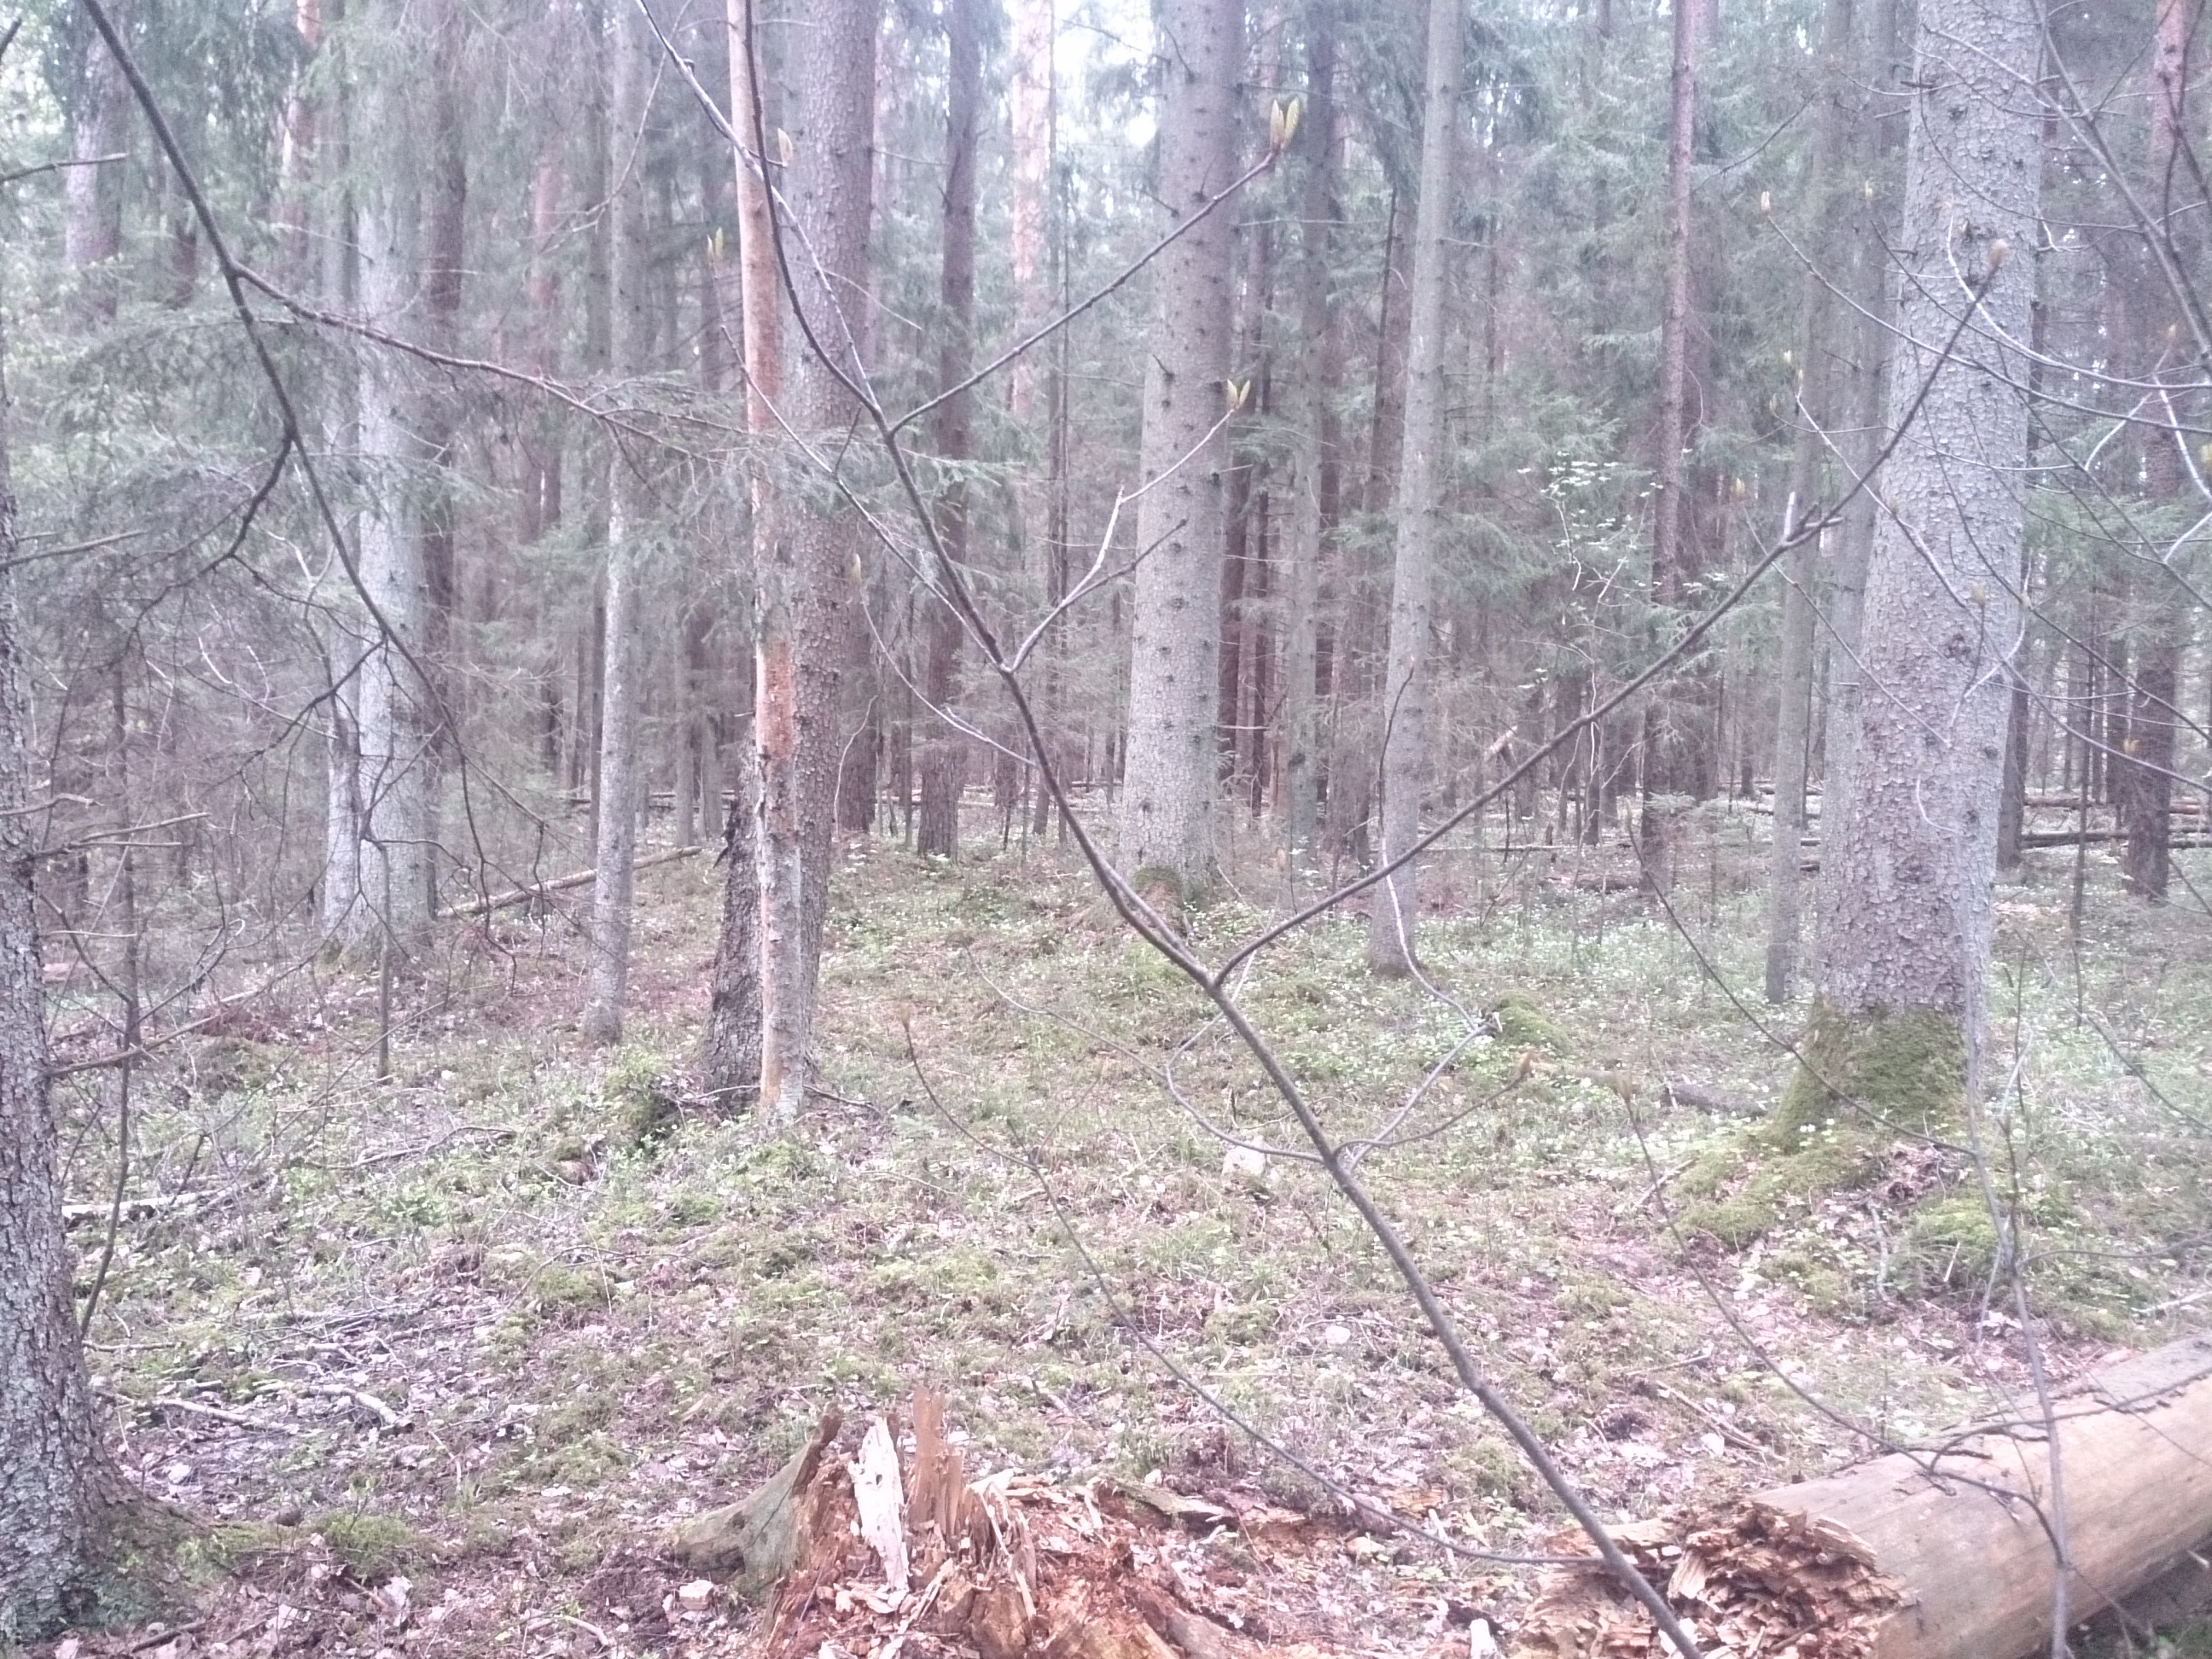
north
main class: Woodland
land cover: Other mixed woodland
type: hemiboreal forest and nemoral coniferous forest and mixed broadleaved-coniferous forest
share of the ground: > 75 %
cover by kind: coniferous forest trees 70 %, broadleaved forest trees 30 %
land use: Forestry
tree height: > 5 m
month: May
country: LV
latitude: 56.6935
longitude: 24.1797
